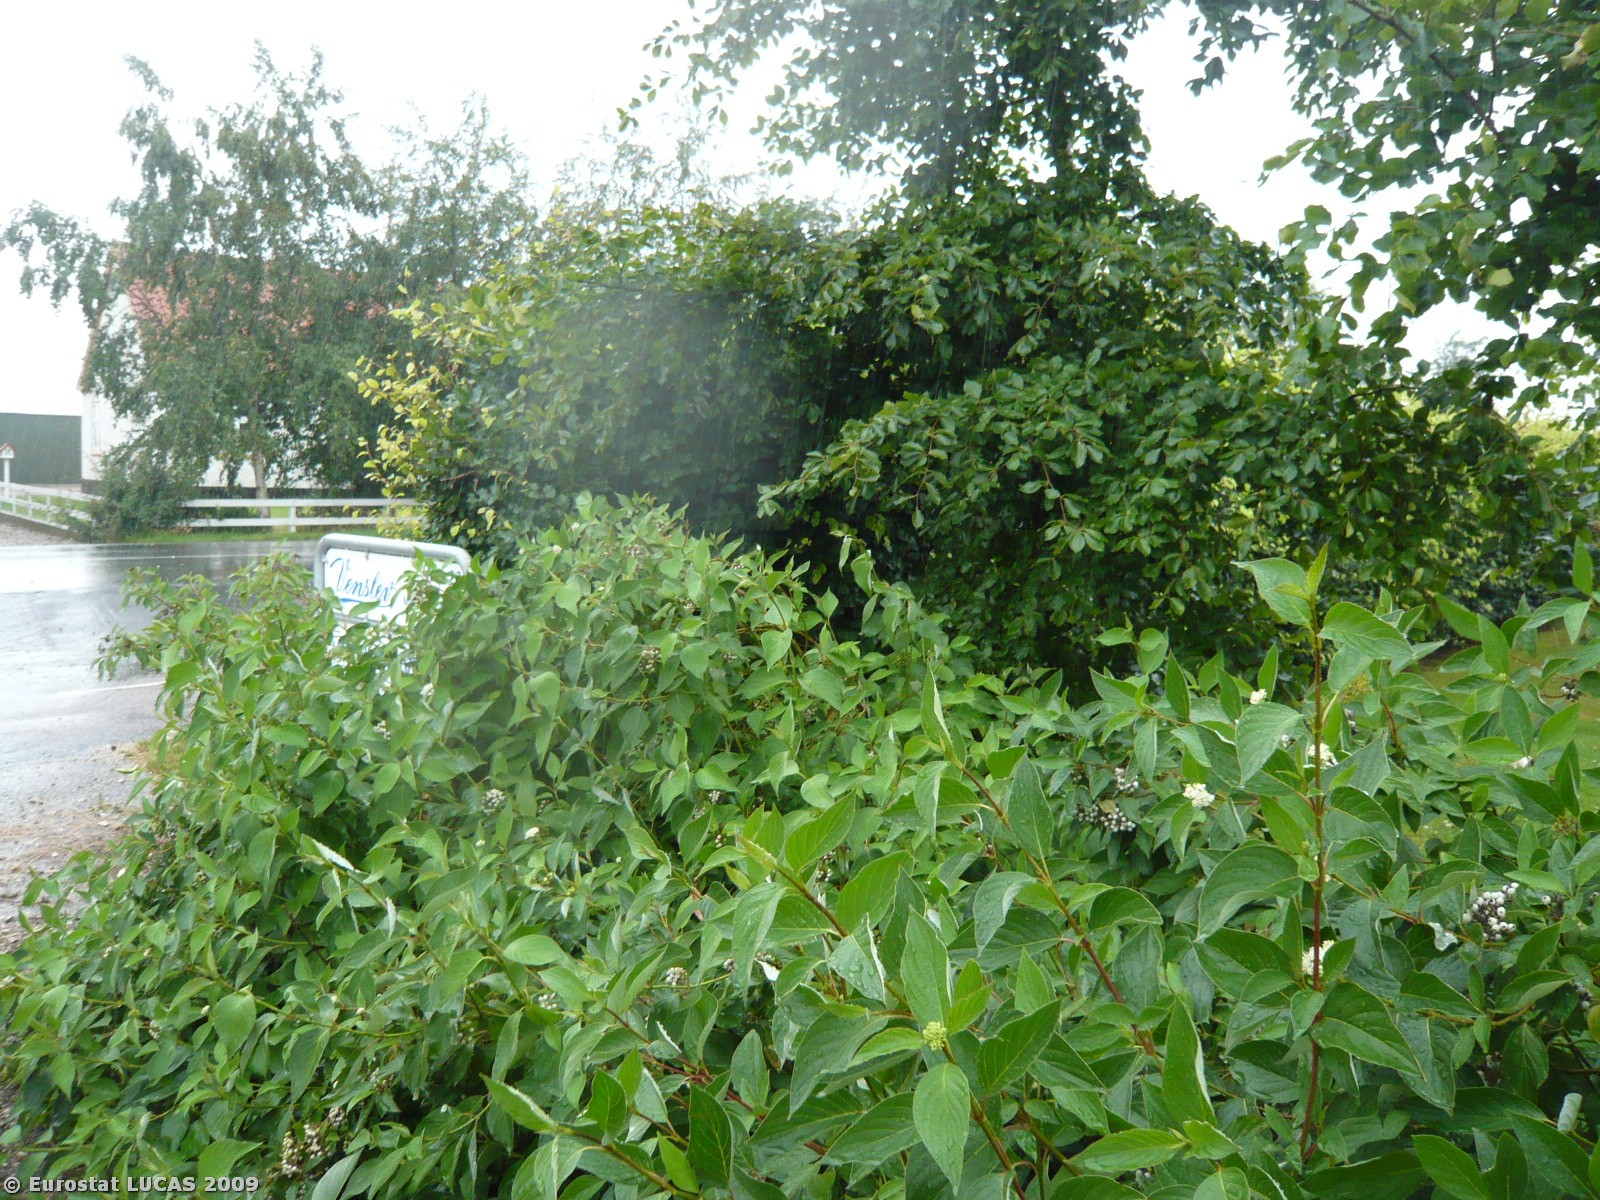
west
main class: Cropland
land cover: Common wheat
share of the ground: > 75 %
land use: Agriculture (excluding fallow land and kitchen gardens)
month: July
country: DK
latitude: 55.7957
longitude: 11.9282
